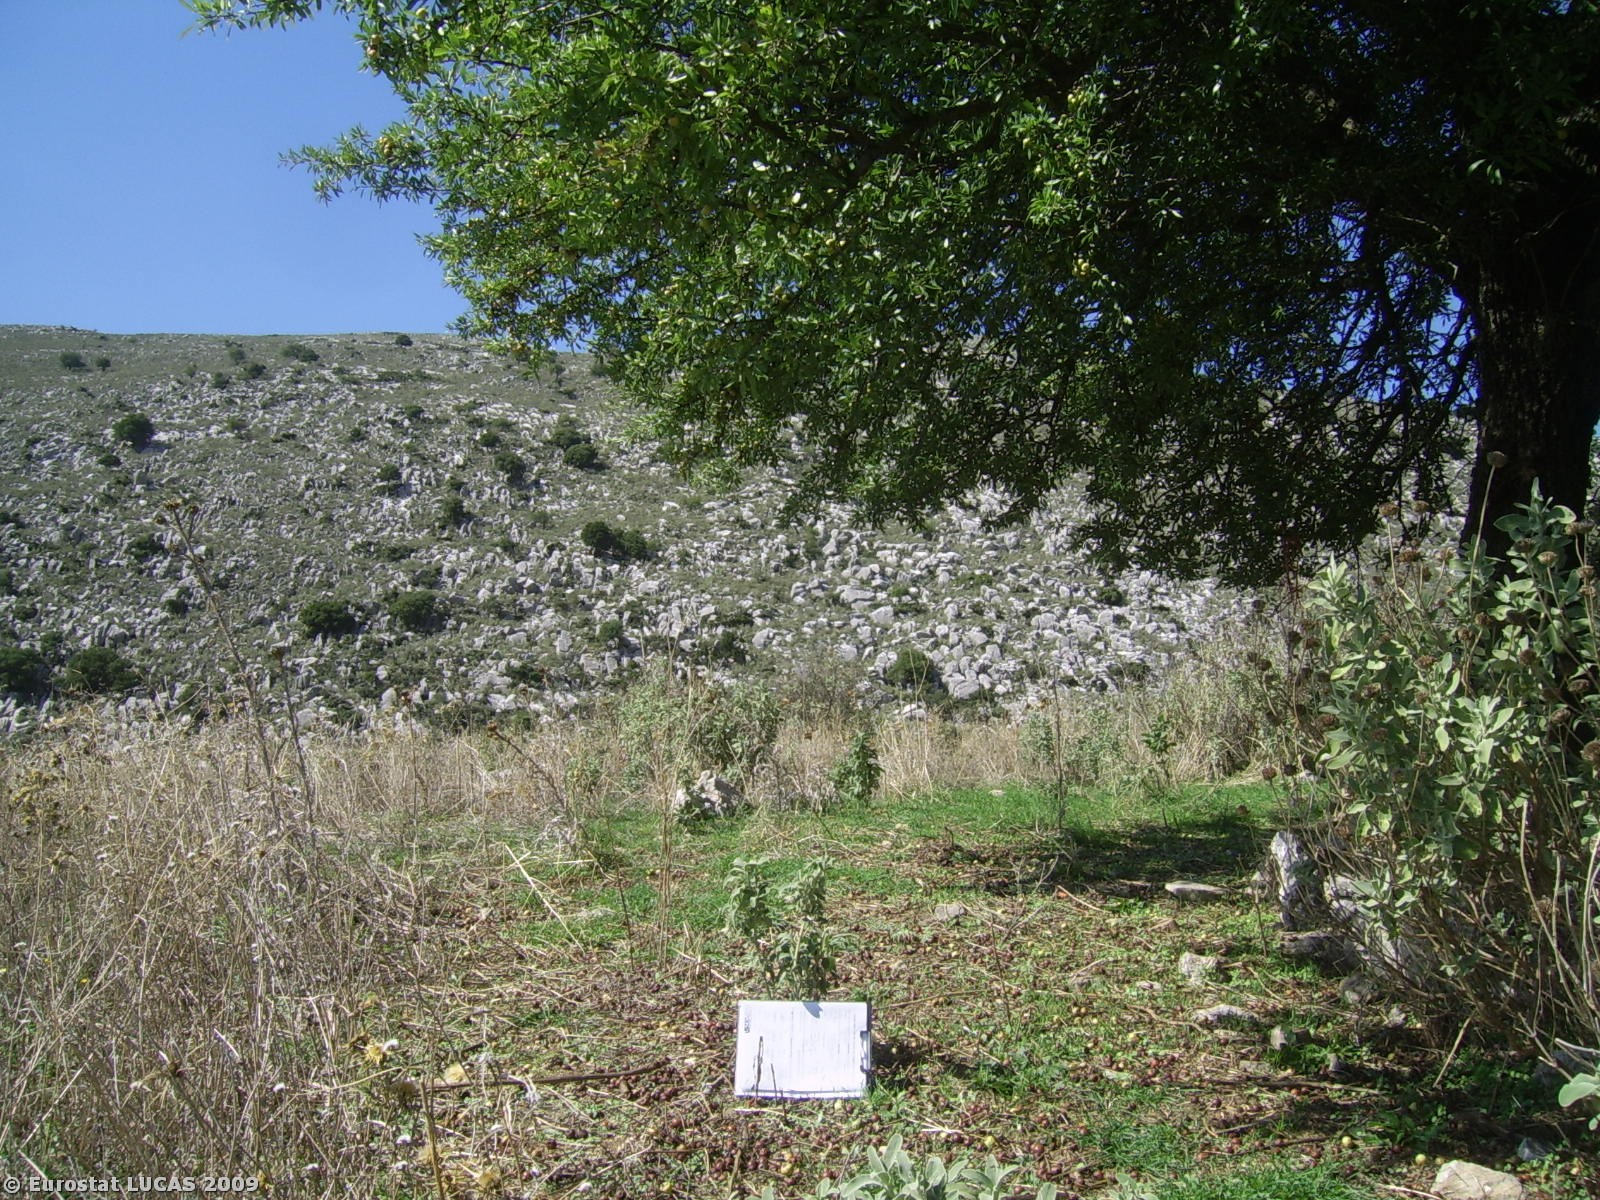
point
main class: Grassland
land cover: Grassland with sparse tree/shrub cover
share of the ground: > 75 %
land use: Unused
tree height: > 5 m
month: October
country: GR
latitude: 37.8461
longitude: 21.7015
